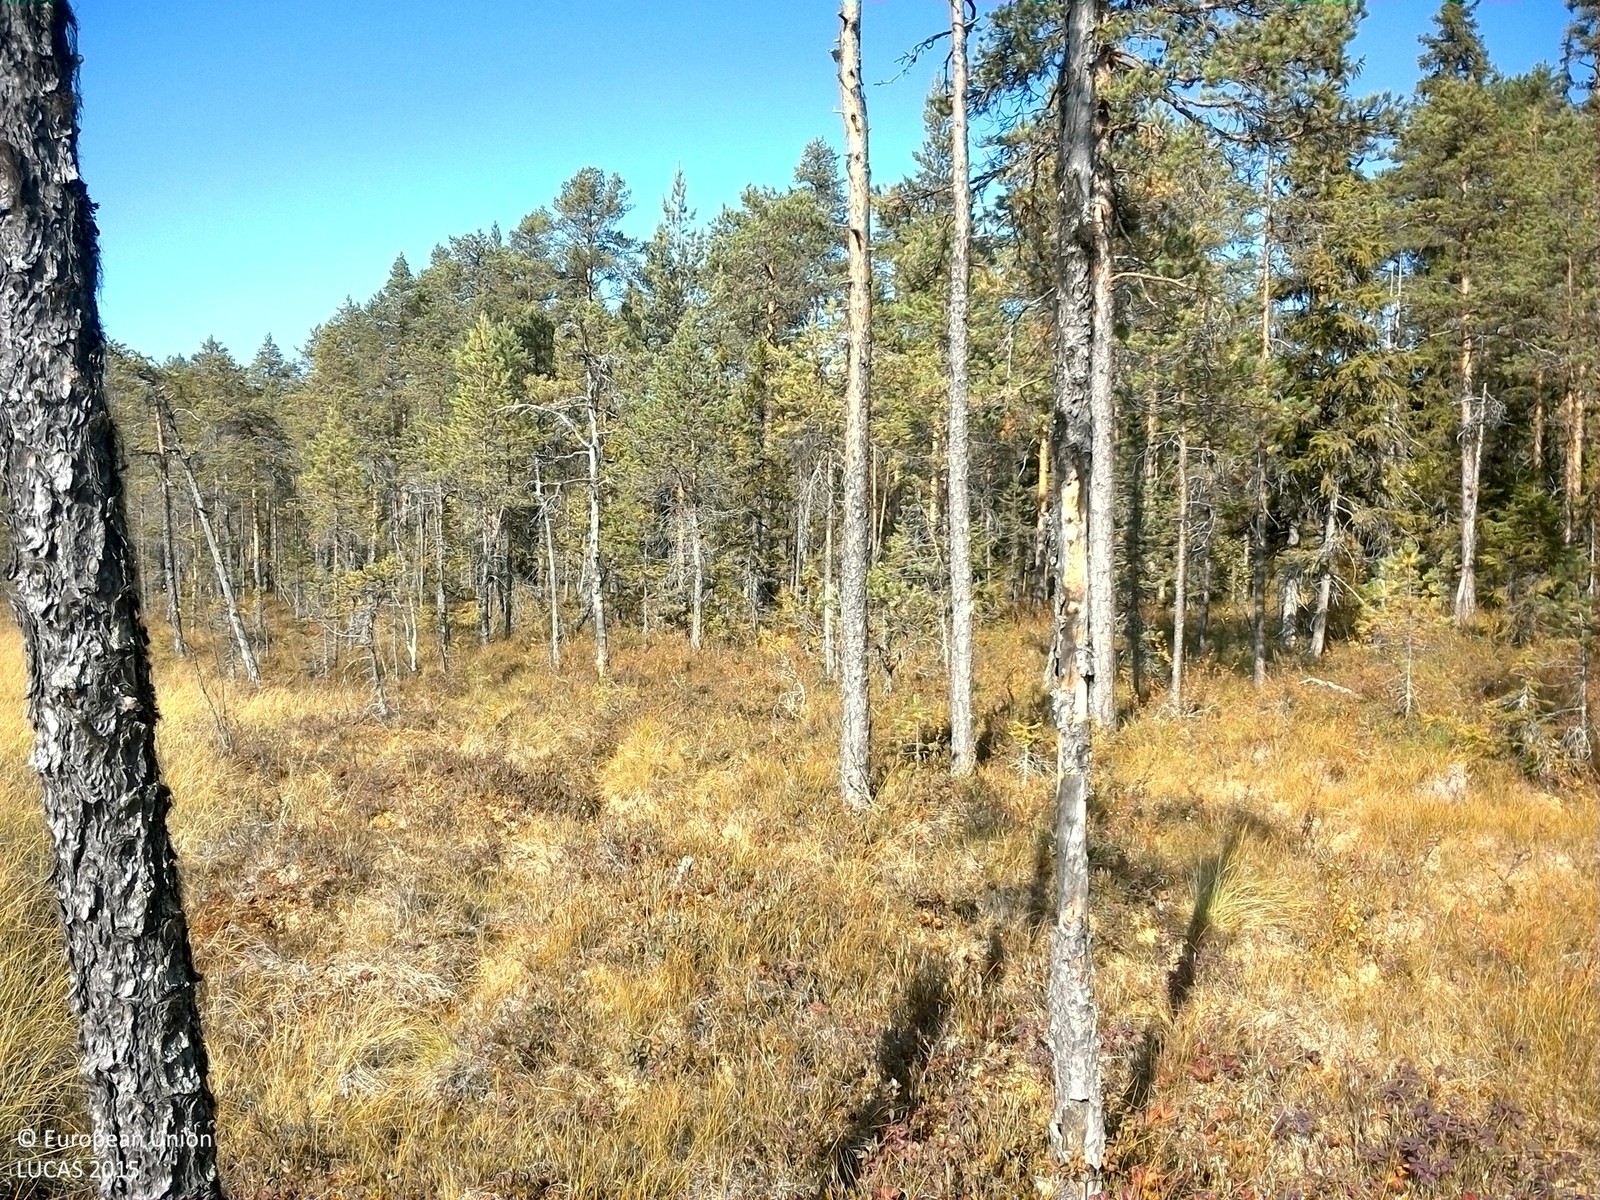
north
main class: Woodland
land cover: Pine dominated coniferous woodland
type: mire and swamp forests
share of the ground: 10 - 25 %
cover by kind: shrubs 35 %, herbaceous plants 35 %, coniferous forest trees 15 %, lichens and mosses 15 %
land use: Semi-natural and natural areas not in use
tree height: < 5 m
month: September
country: SE
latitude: 63.9592
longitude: 16.4431
